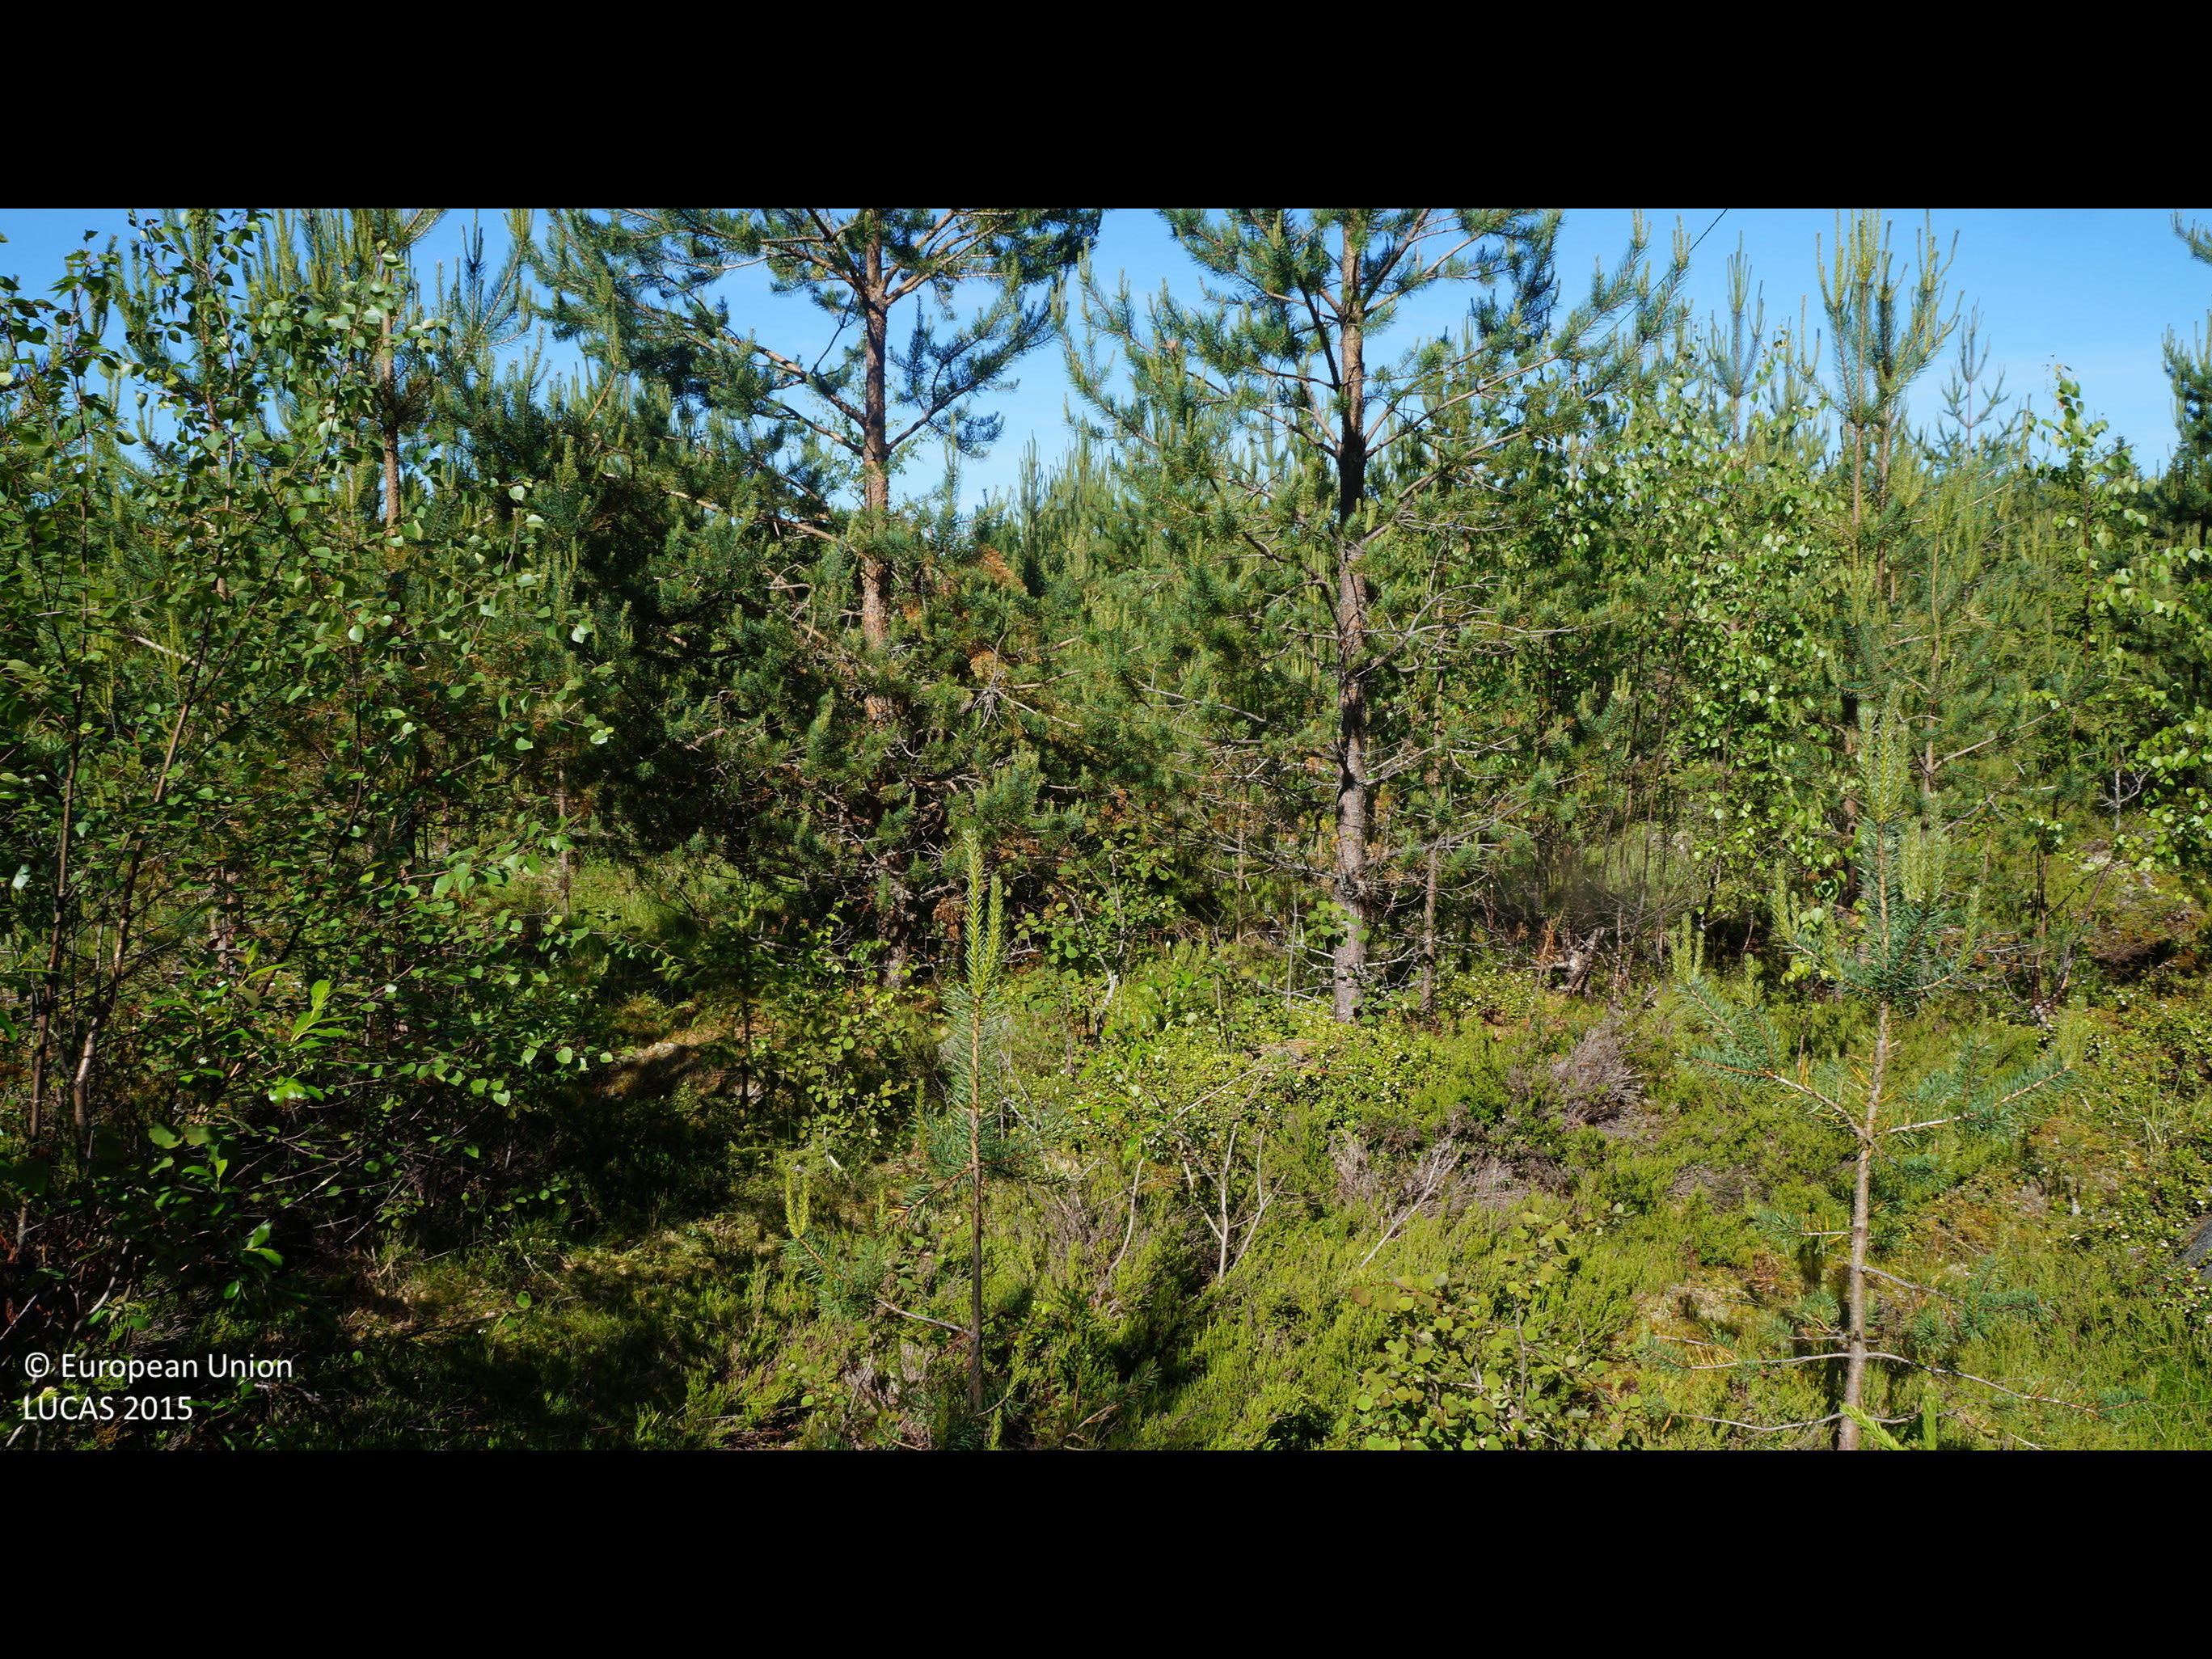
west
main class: Woodland
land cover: Pine dominated coniferous woodland
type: boreal forest
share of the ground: 50 - 75 %
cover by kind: coniferous forest trees 50 %, shrubs 30 %, broadleaved forest trees 10 %, herbaceous plants 5 %, lichens and mosses 5 %
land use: Forestry
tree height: < 5 m
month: July
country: FI
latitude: 64.2433
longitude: 24.6992
